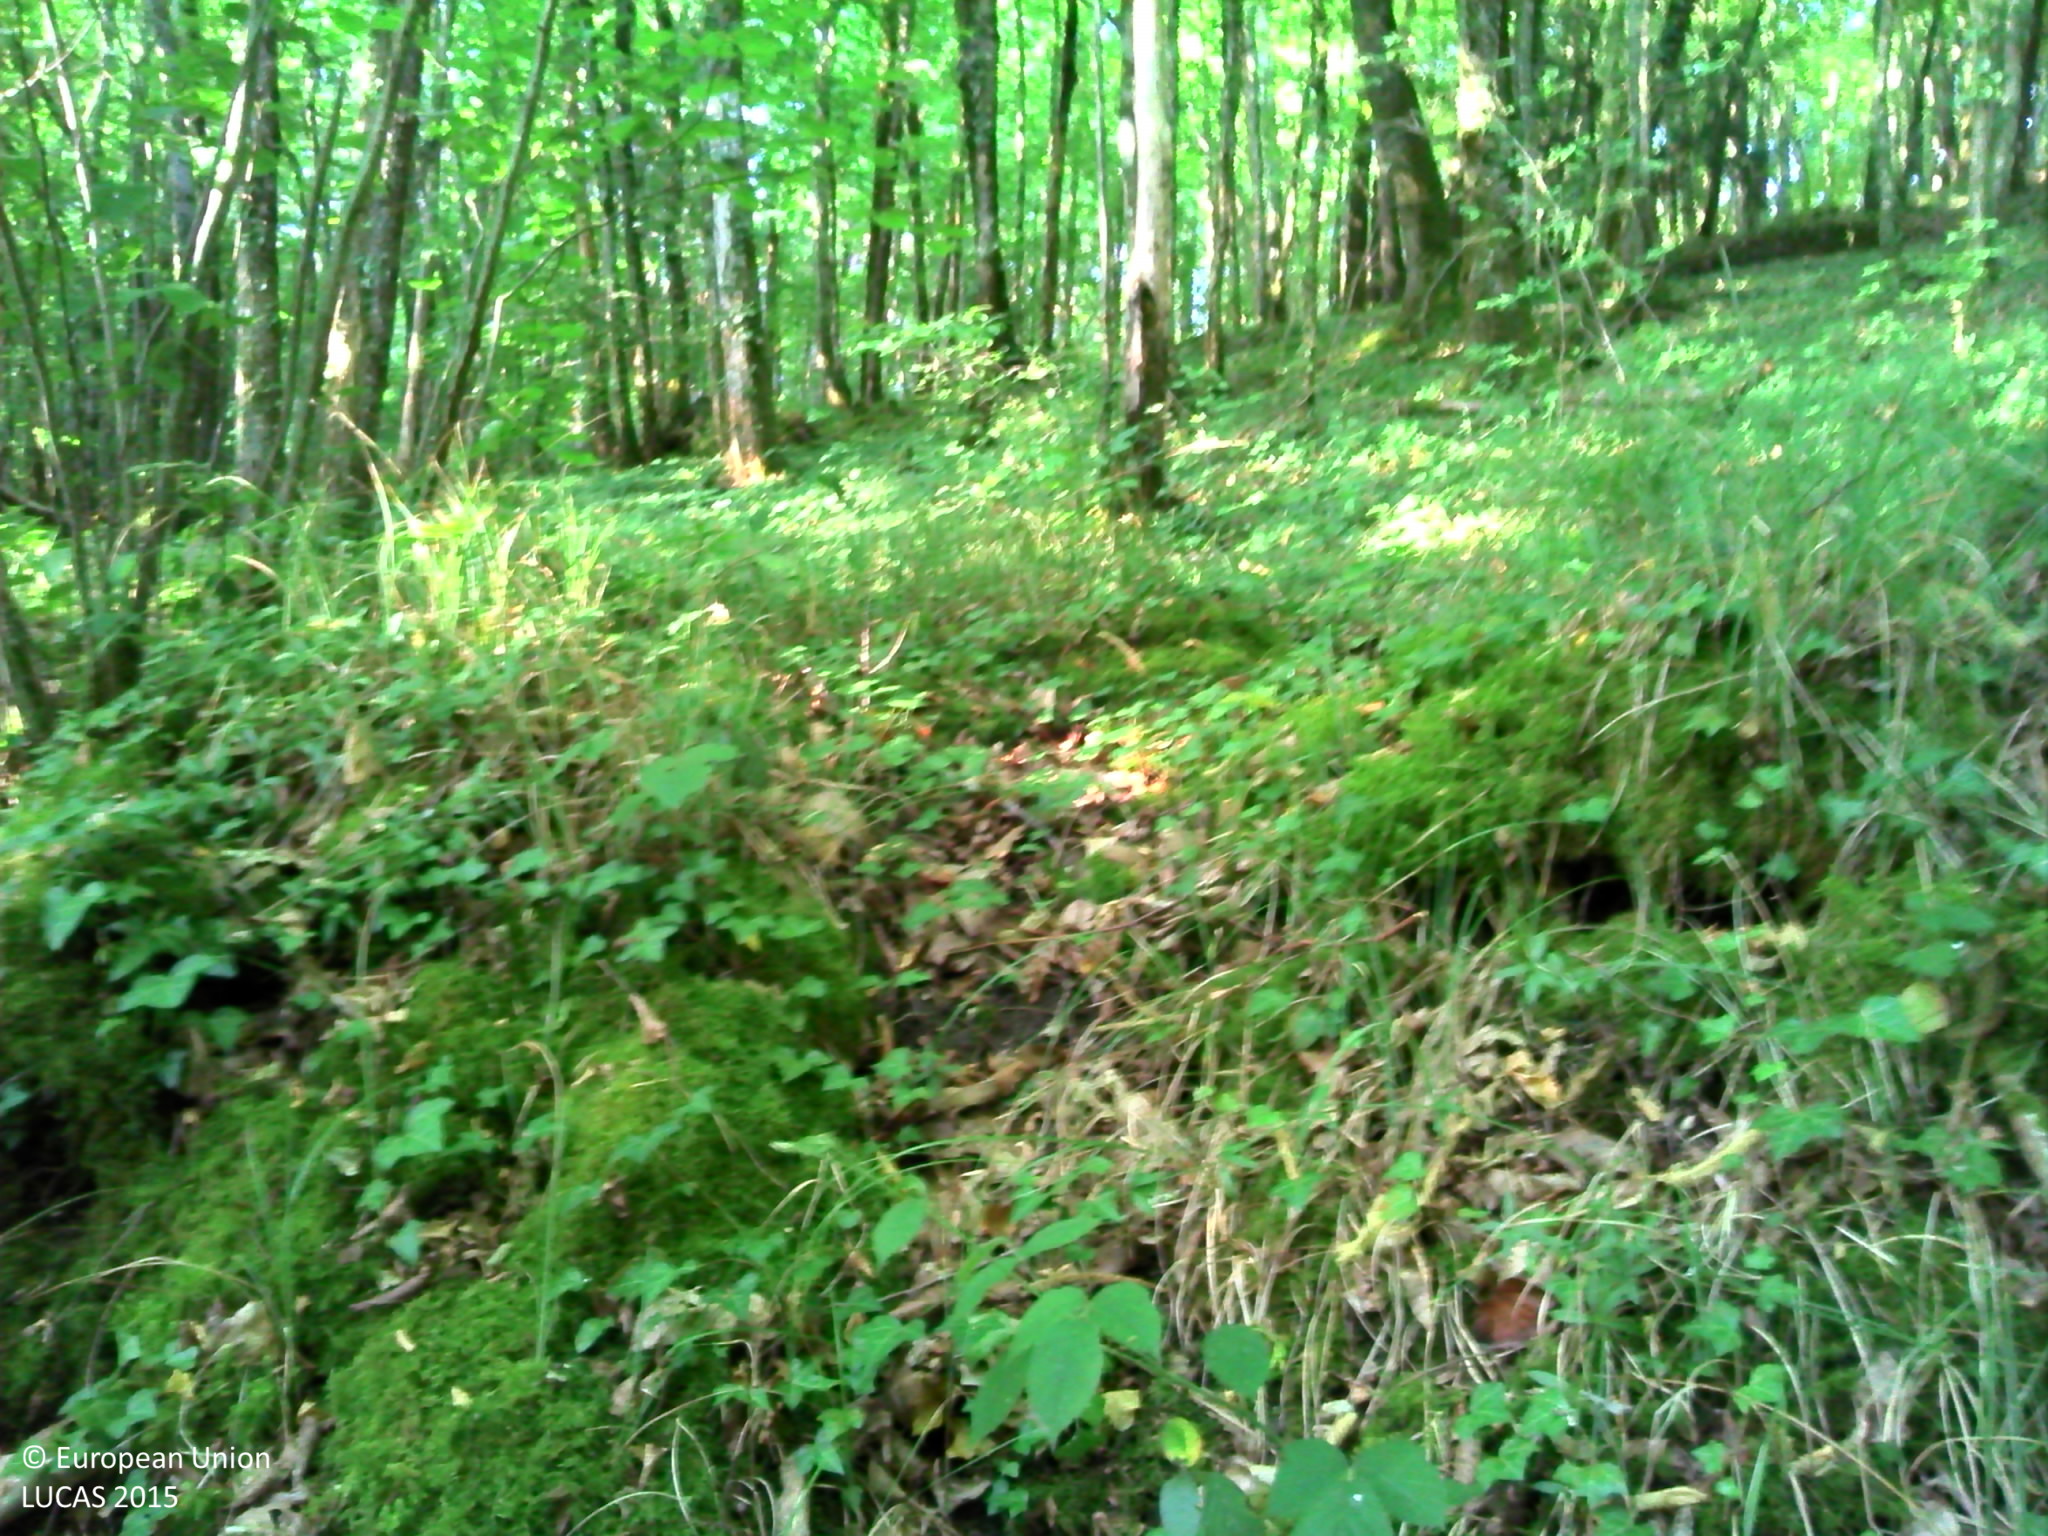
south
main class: Woodland
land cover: Broadleaved woodland
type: beech forest
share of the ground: > 75 %
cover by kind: broadleaved forest trees 80 %, herbaceous plants 10 %, lichens and mosses 10 %
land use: Forestry
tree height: > 5 m
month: July
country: FR
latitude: 45.1327
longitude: 1.1562
